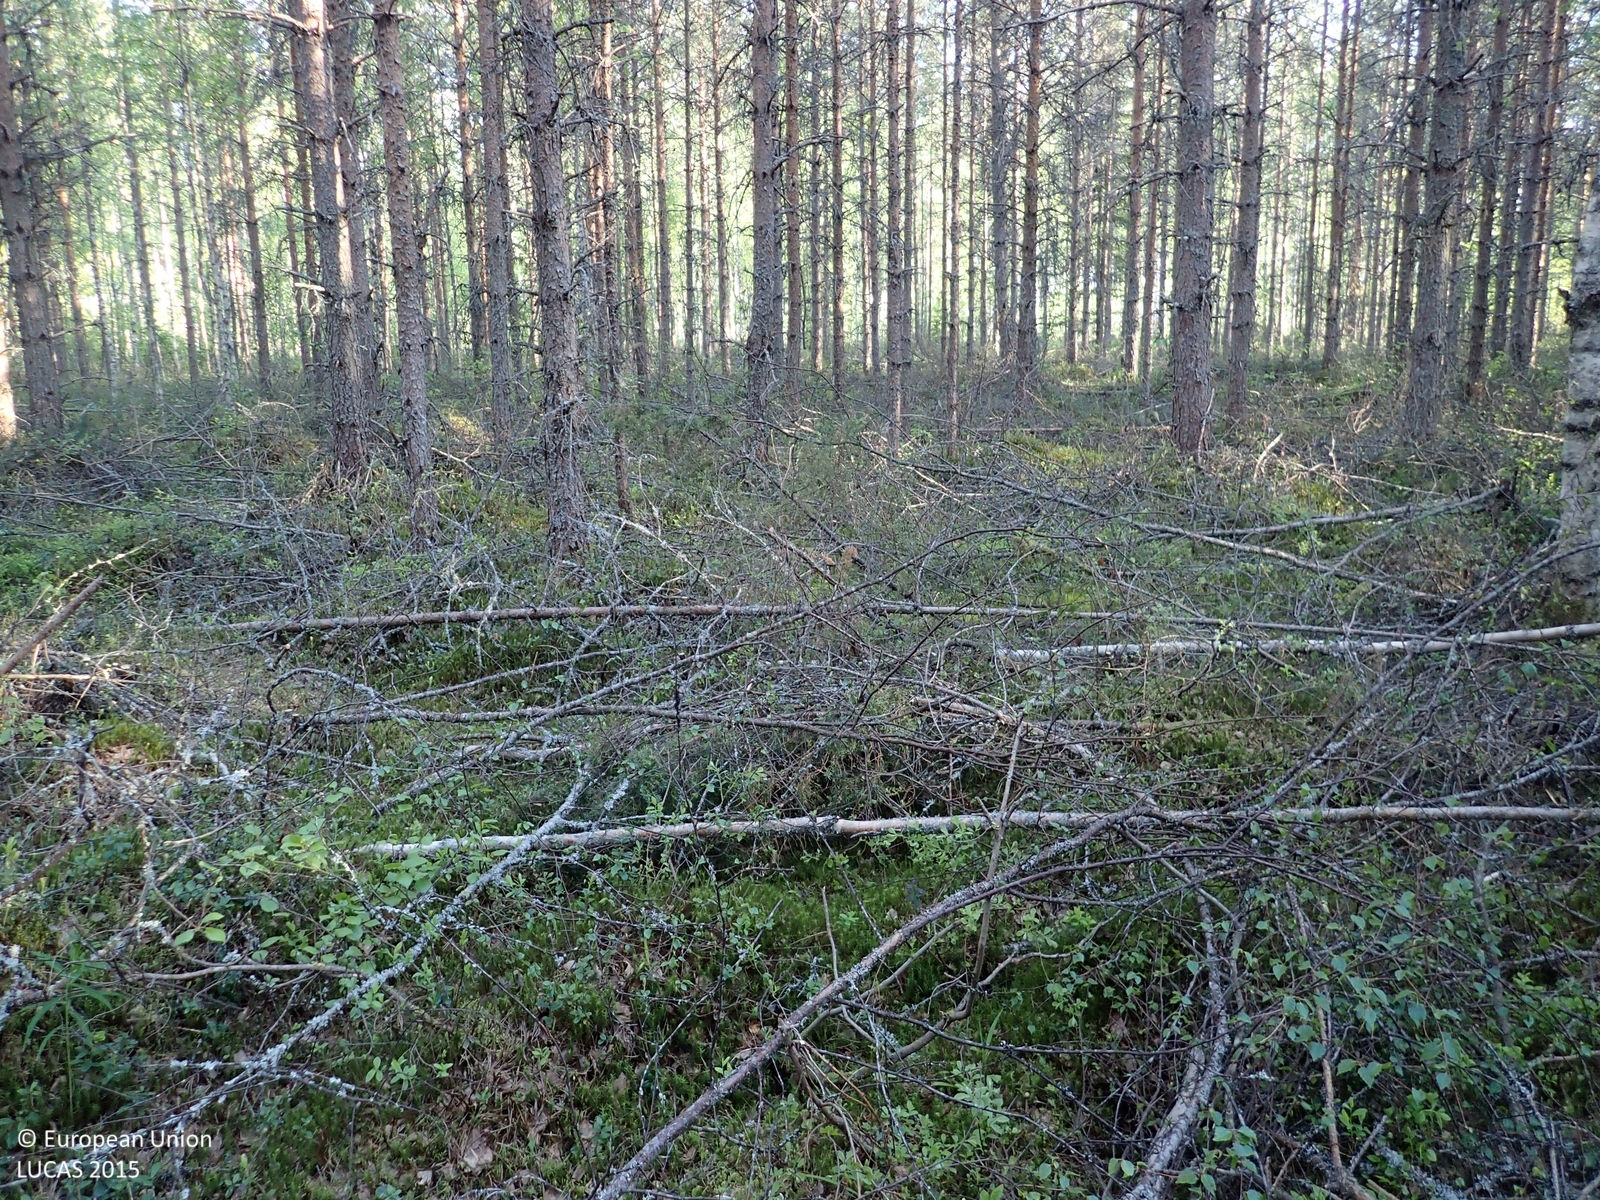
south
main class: Woodland
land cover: Pine dominated mixed woodland
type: boreal forest
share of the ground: > 75 %
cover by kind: coniferous forest trees 55 %, broadleaved forest trees 25 %, shrubs 20 %
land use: Forestry
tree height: > 5 m
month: June
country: FI
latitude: 62.1818
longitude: 22.4858
